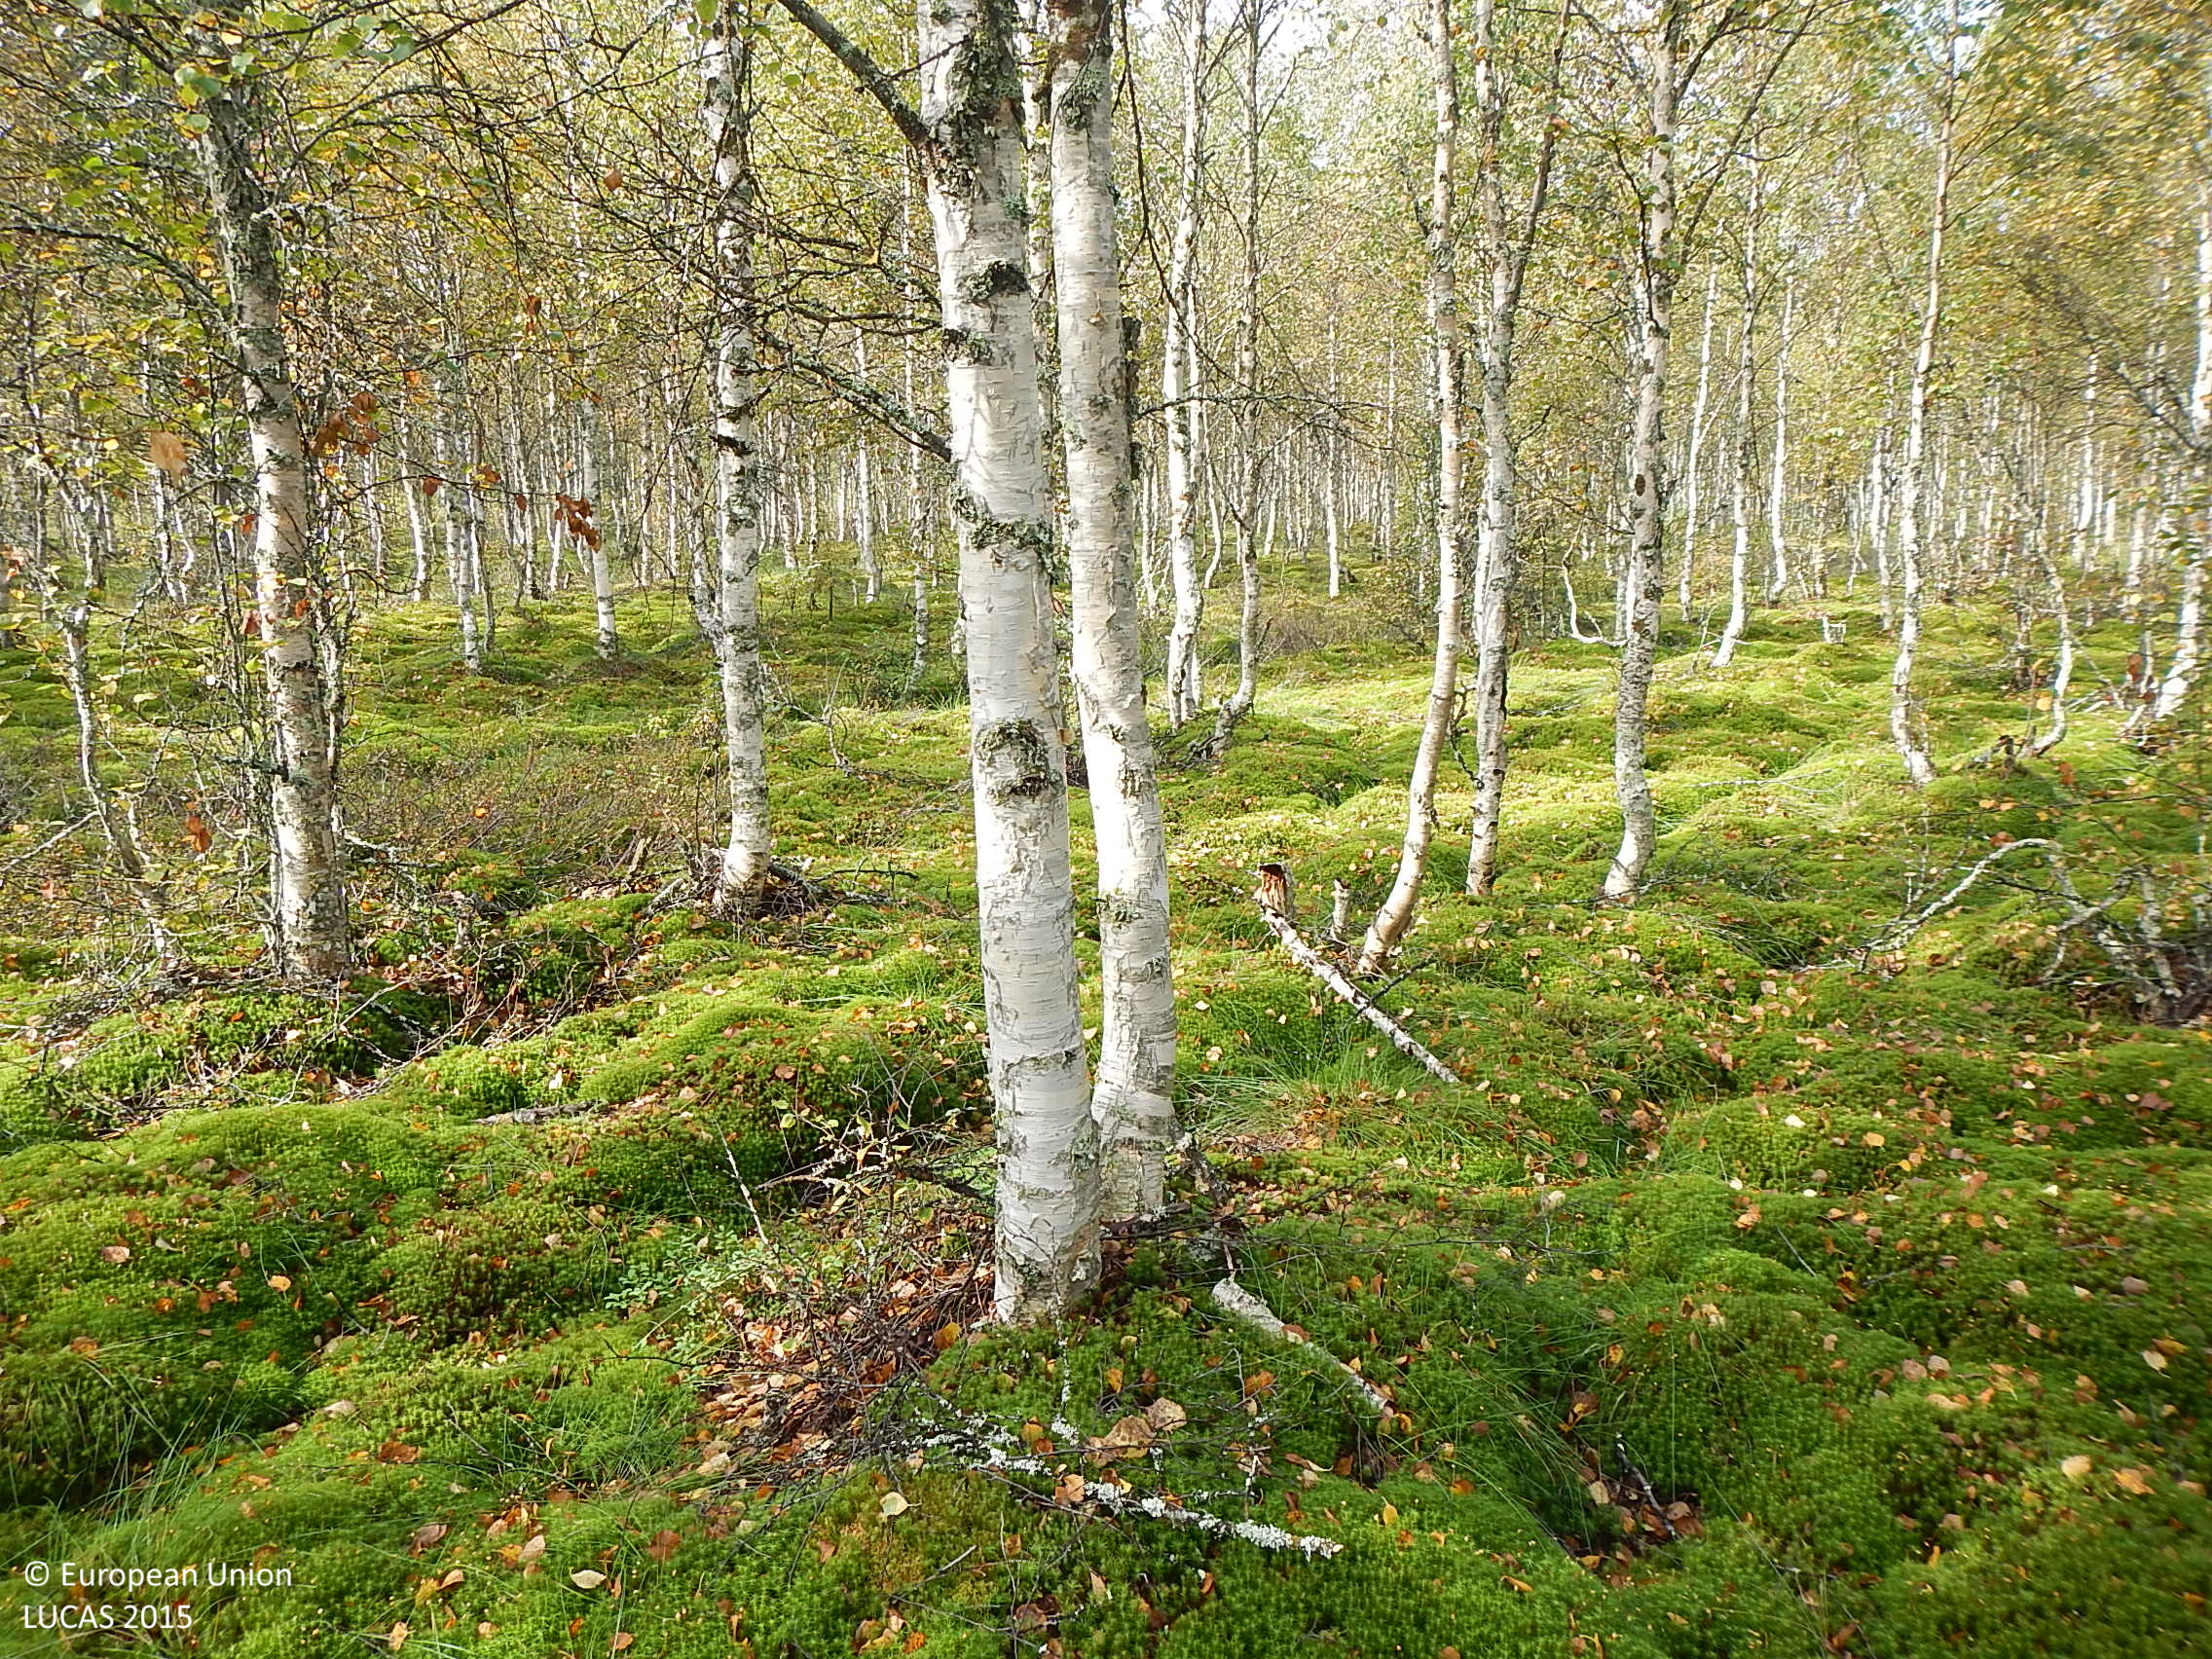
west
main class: Woodland
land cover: Broadleaved woodland
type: mire and swamp forests
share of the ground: > 75 %
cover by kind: broadleaved forest trees 75 %, lichens and mosses 20 %, herbaceous plants 5 %
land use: Forestry
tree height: > 5 m
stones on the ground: < 10 %
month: August
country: FI
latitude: 65.7415
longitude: 26.9719
